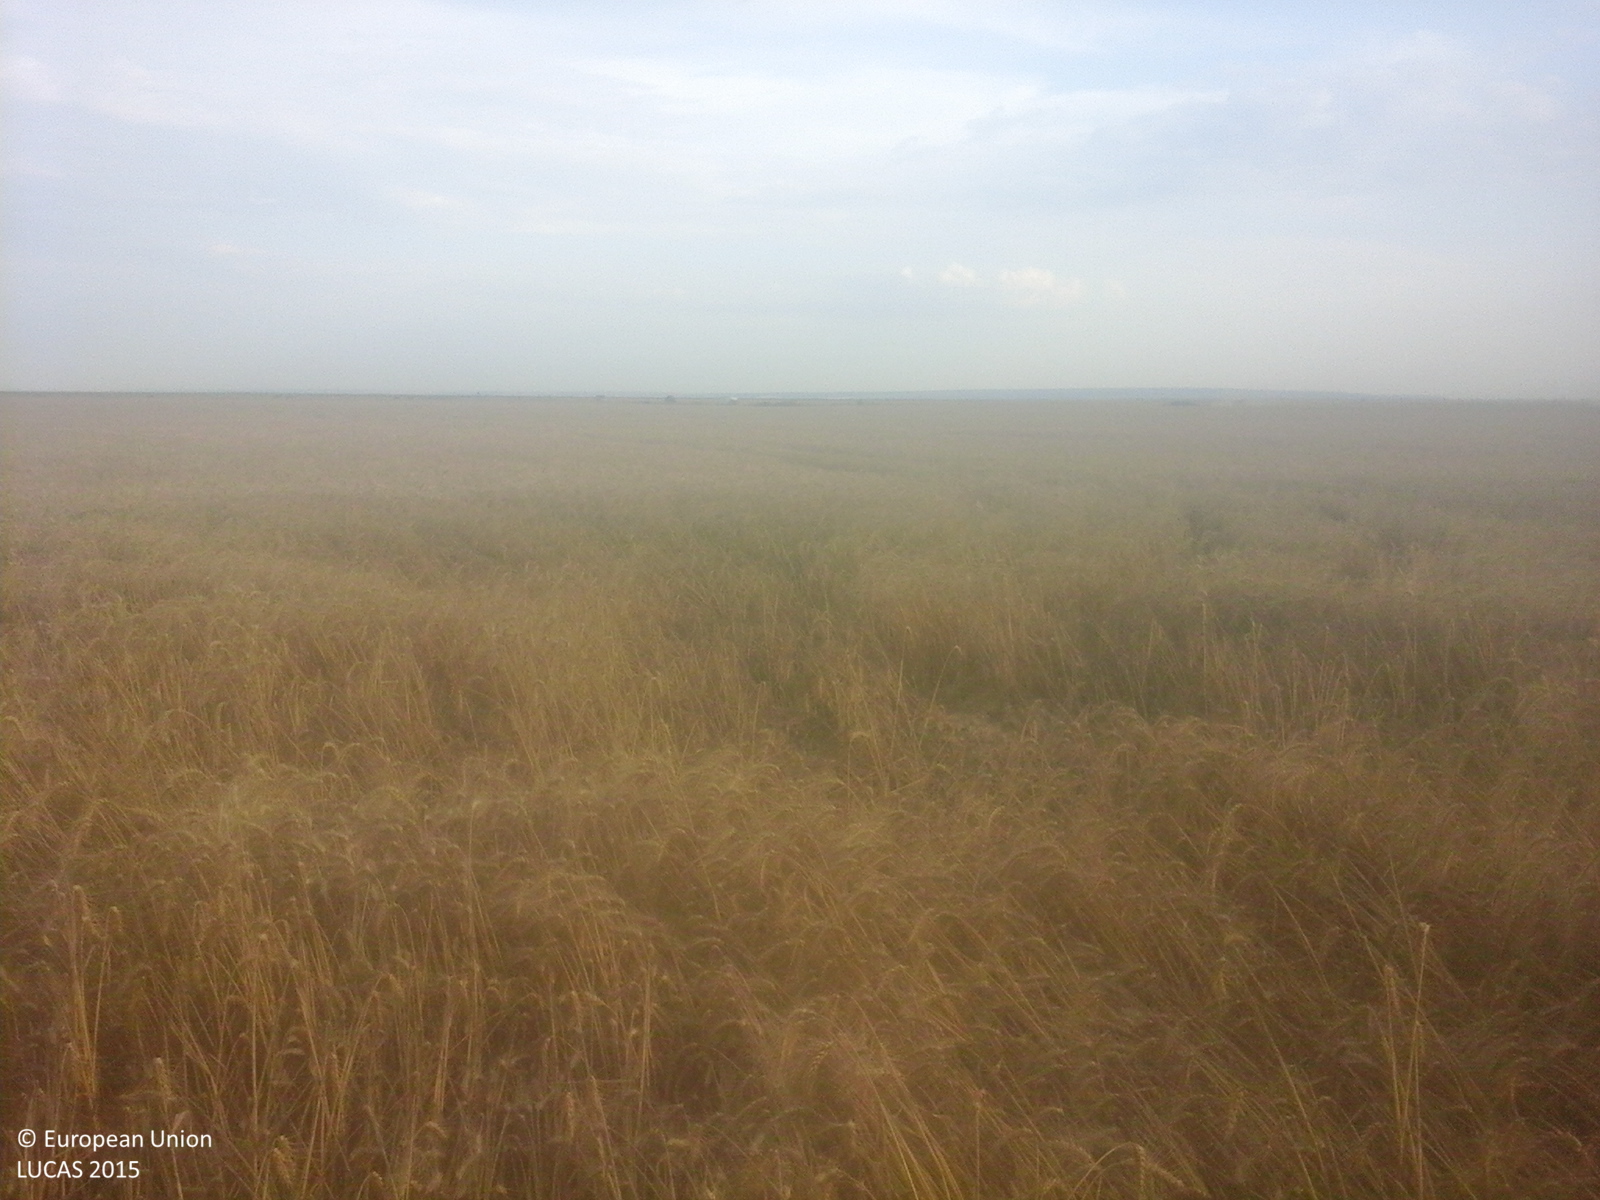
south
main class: Cropland
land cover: Common wheat
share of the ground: > 75 %
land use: Agriculture (excluding fallow land and kitchen gardens)
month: July
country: RO
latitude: 43.8483
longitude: 24.5578
